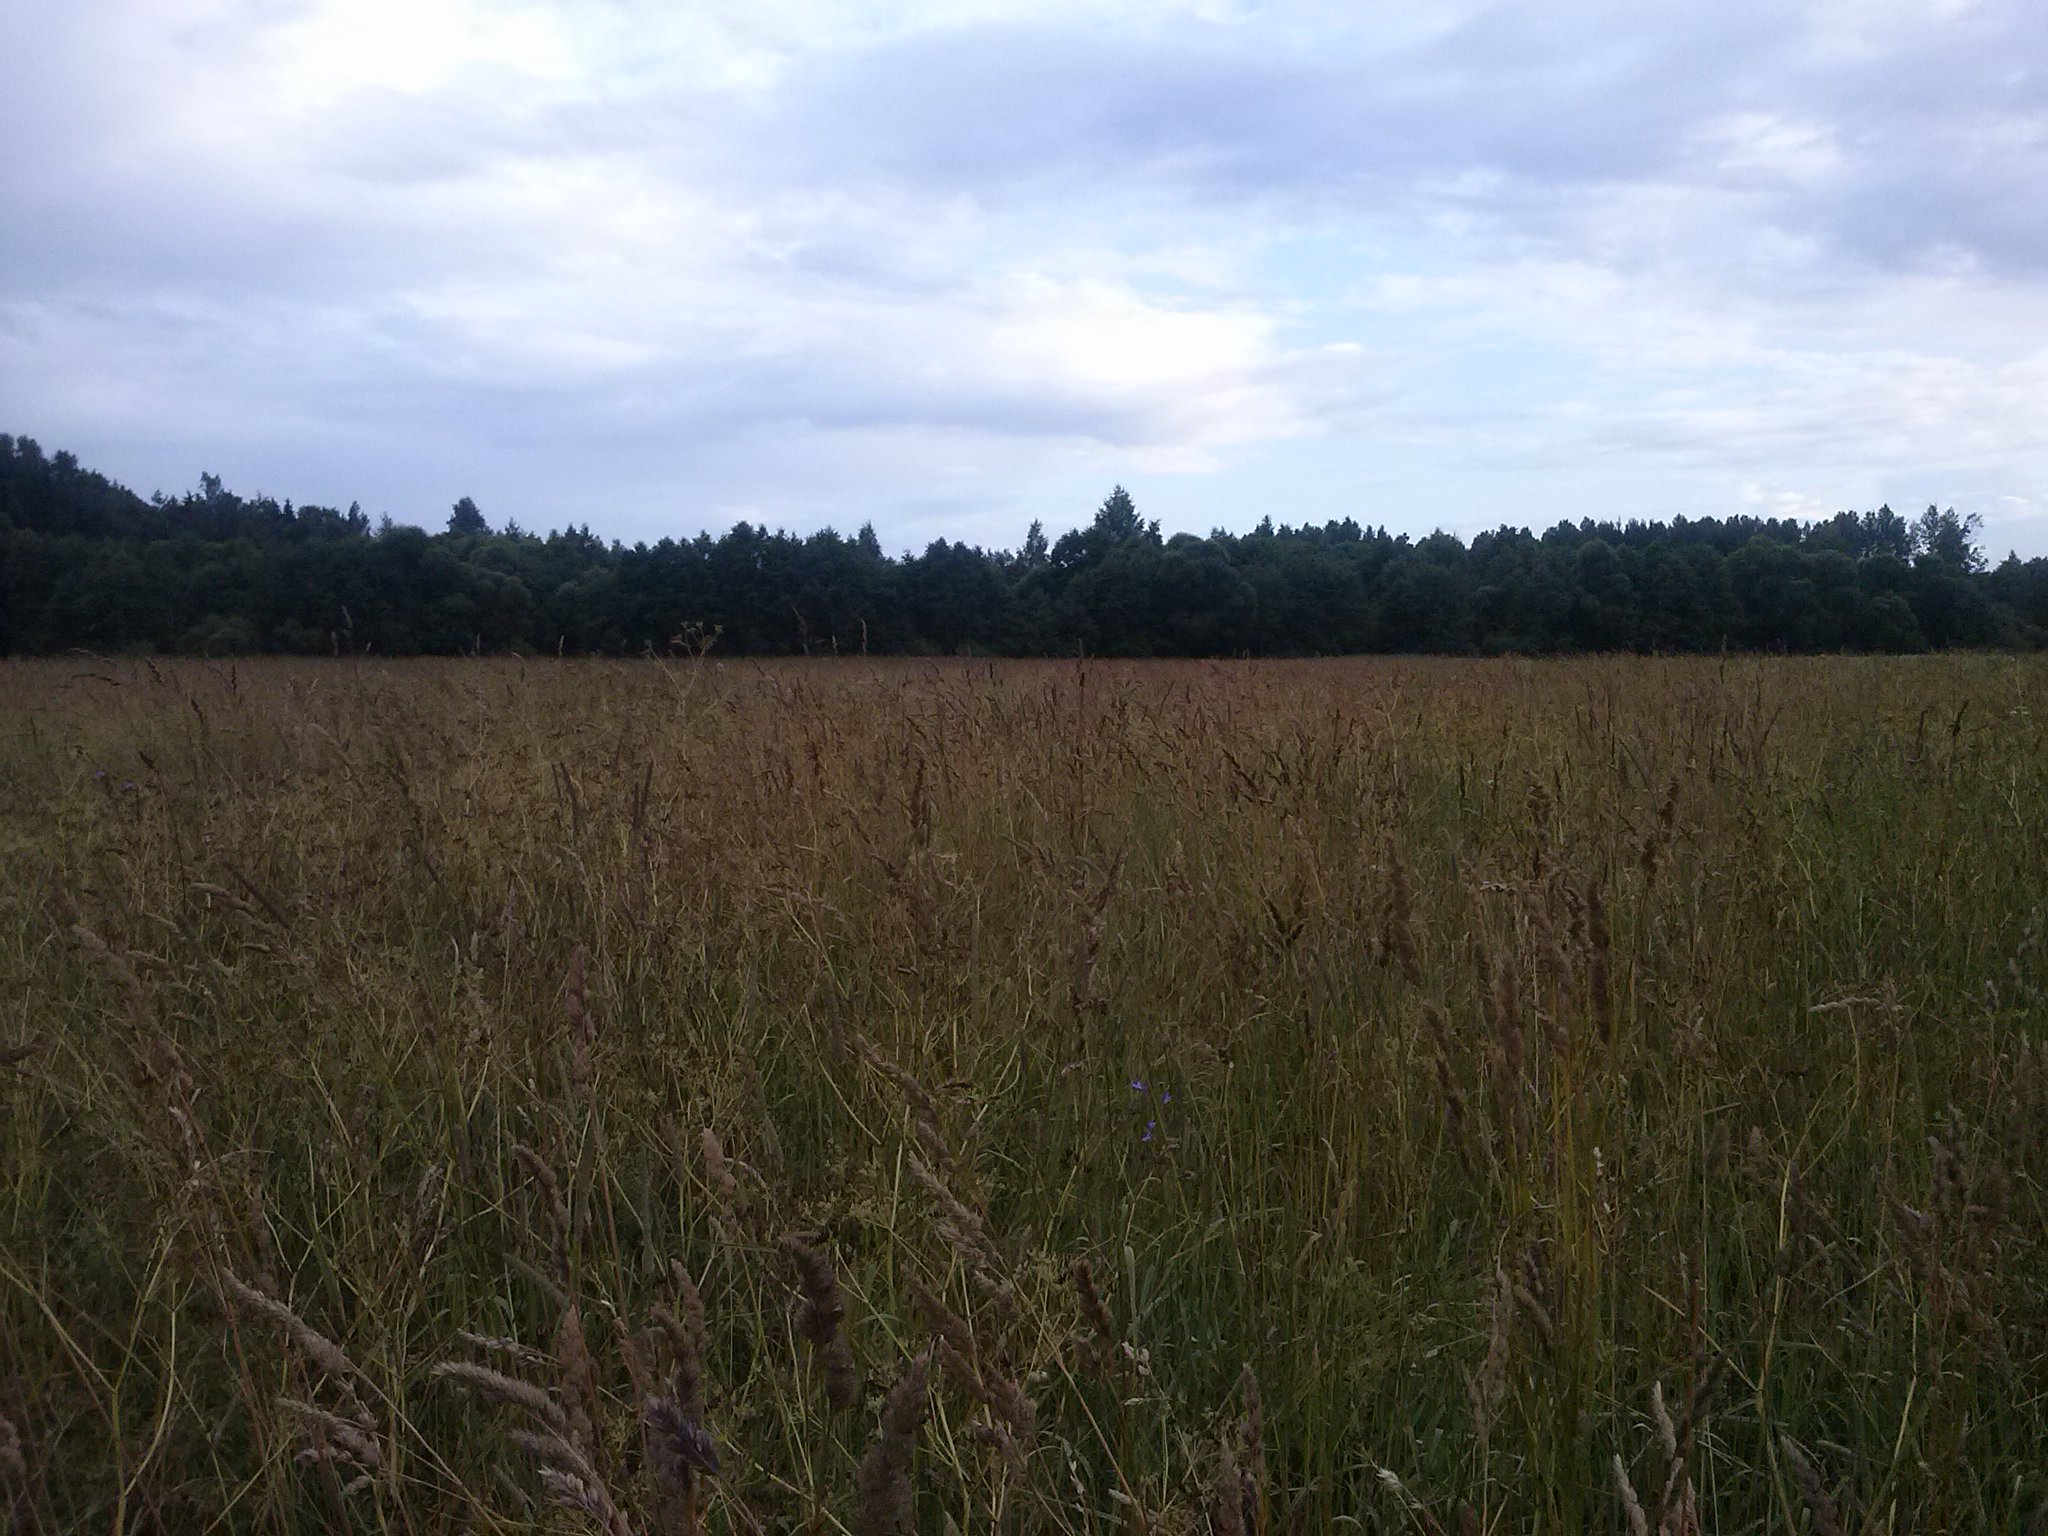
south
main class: Grassland
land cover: Grassland without tree/shrub cover
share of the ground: > 75 %
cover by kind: herbaceous plants 100 %
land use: Agriculture (excluding fallow land and kitchen gardens)
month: July
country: LV
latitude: 56.7606
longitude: 27.7718
